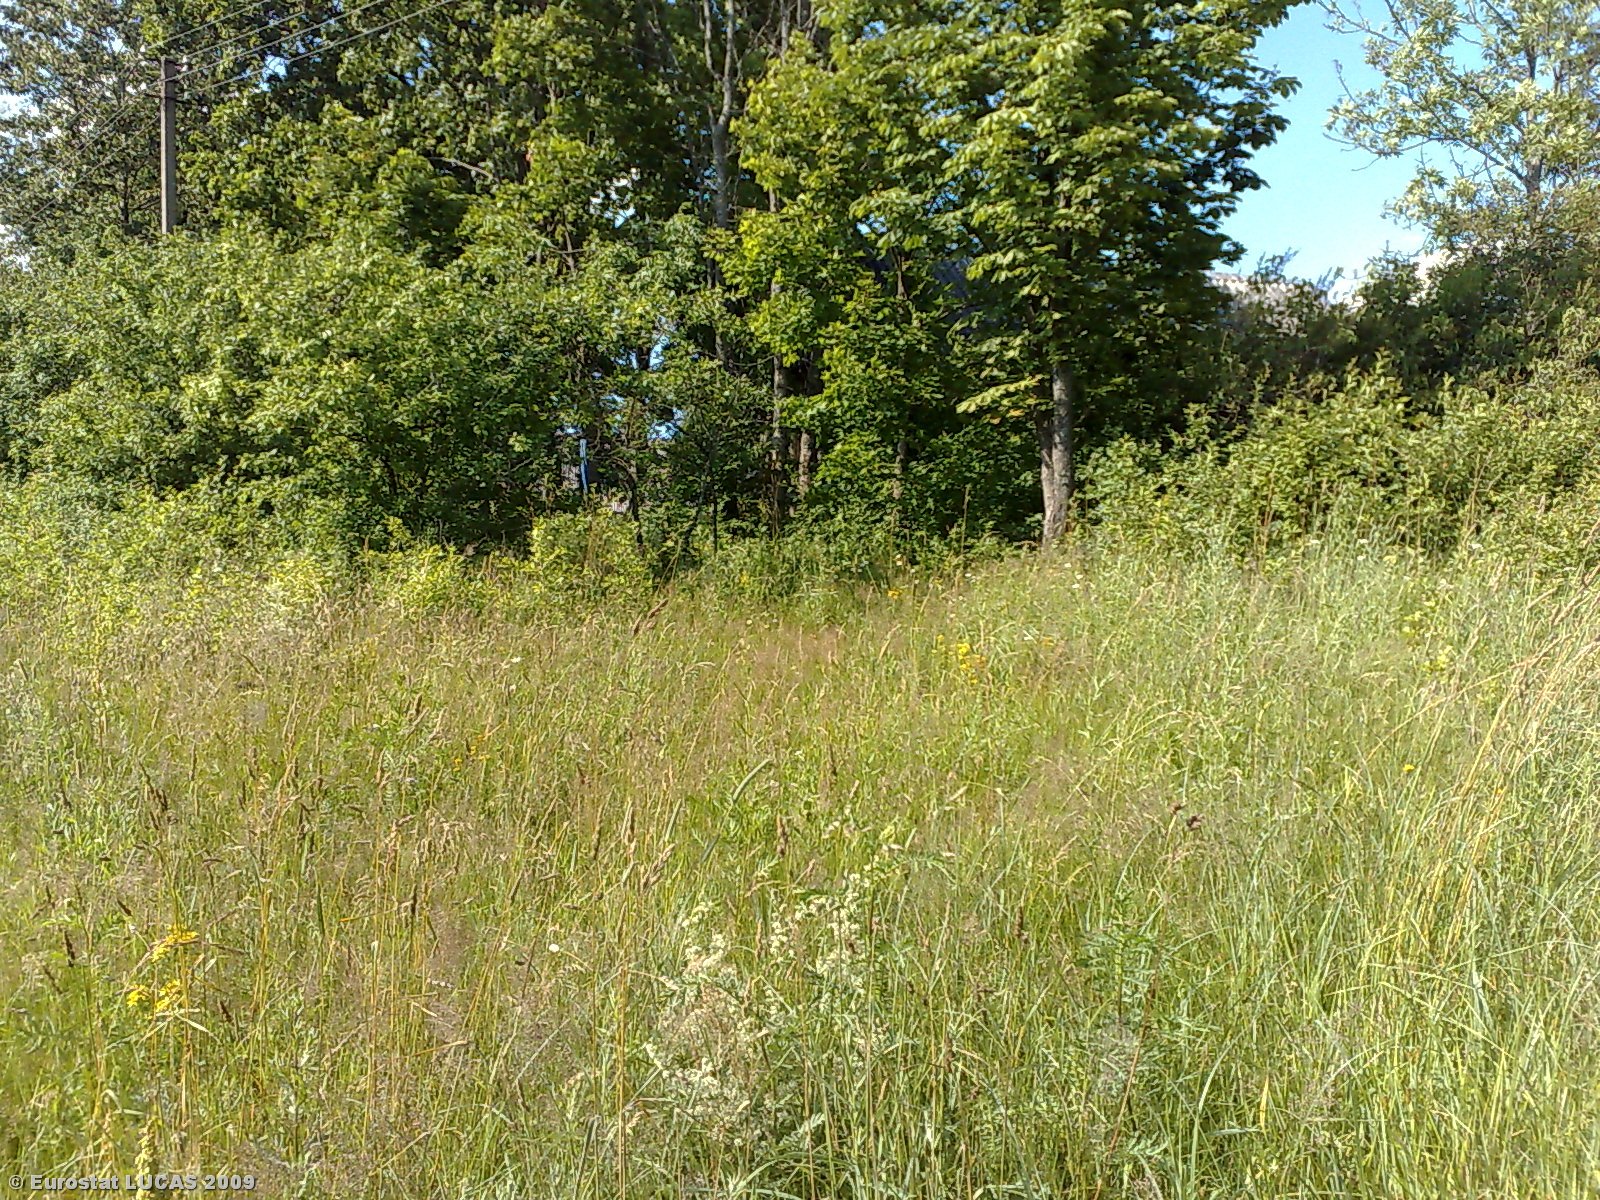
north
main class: Grassland
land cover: Grassland without tree/shrub cover
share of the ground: > 75 %
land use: Agriculture (excluding fallow land and kitchen gardens)
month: July
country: LT
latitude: 55.4975
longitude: 22.7125
